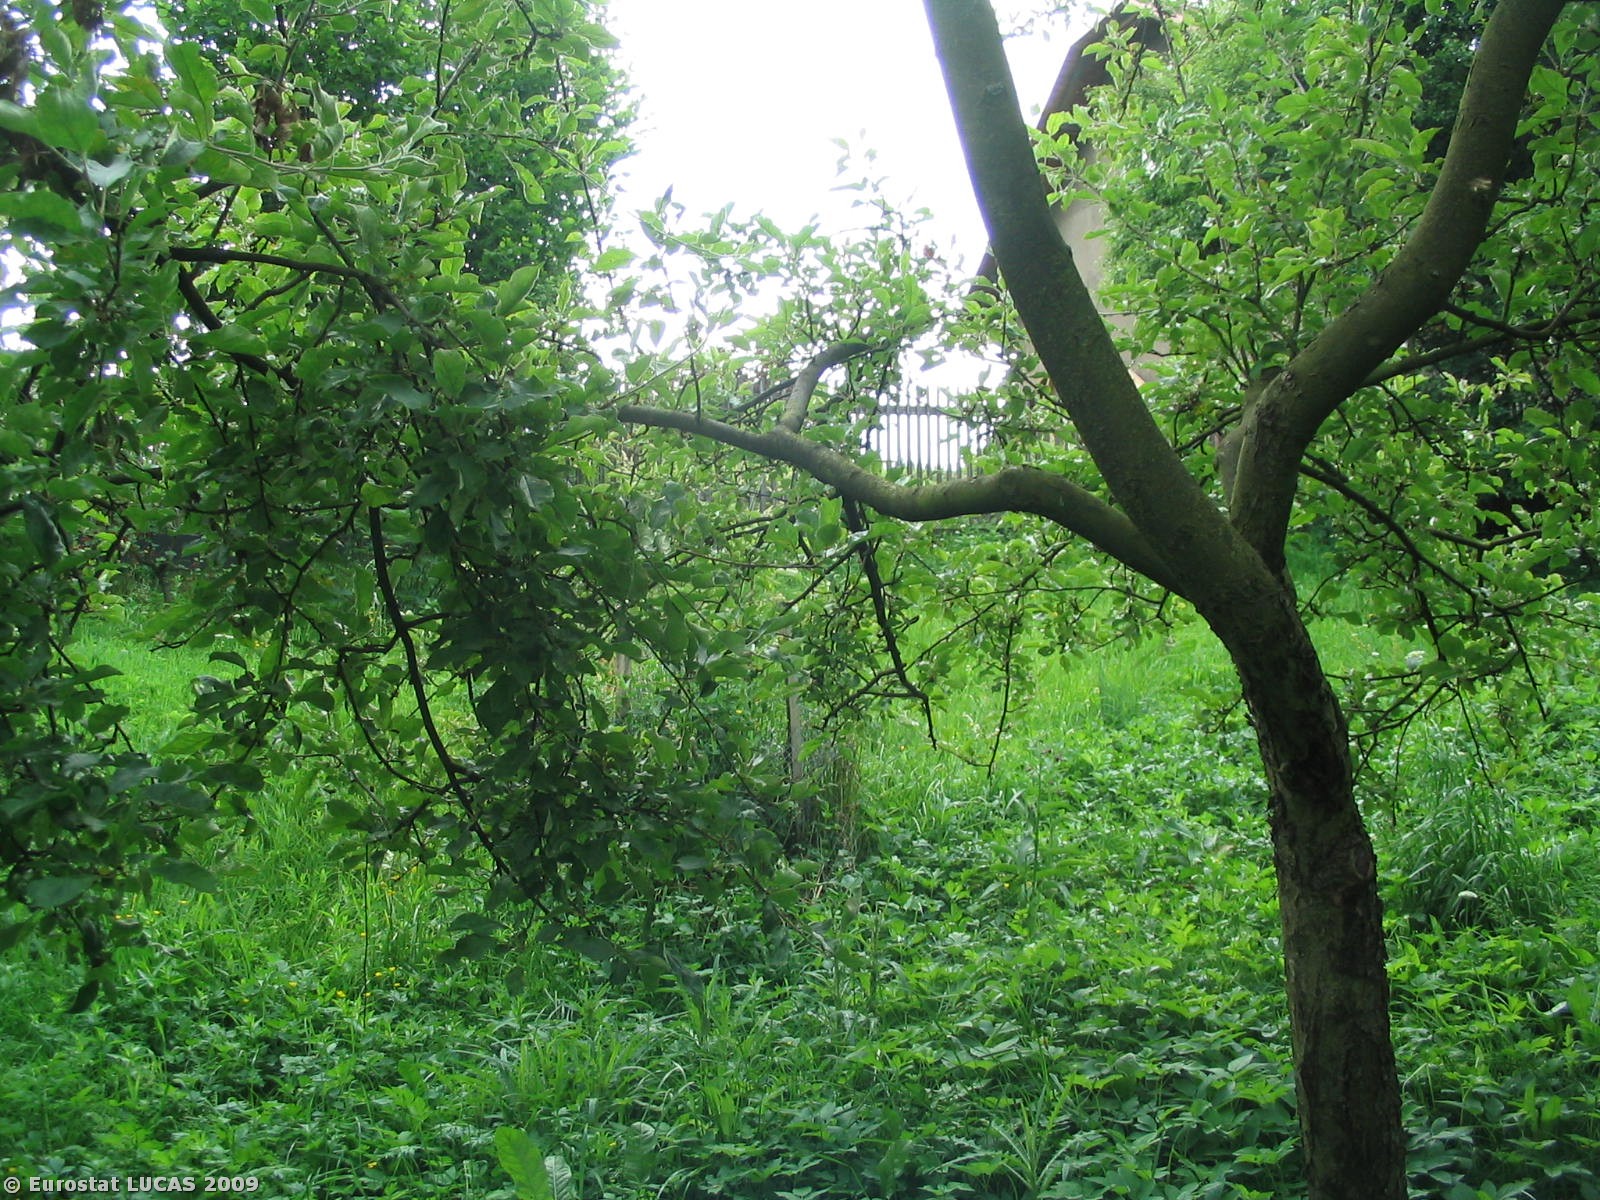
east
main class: Cropland
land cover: Apple fruit
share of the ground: 50 - 75 %
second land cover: Grassland with sparse tree/shrub cover
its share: > 75 %
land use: Kitchen garden
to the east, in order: Apple fruit; Grassland with sparse tree/shrub cover; Fences; Artificial constructions in urban areas; Fences; Broadleaved woodland; Electric lines; Grassland without tree/shrub cover; Fences; Artificial constructions in urban areas; Fences; Grass margins; Tracks; Electric lines; Grassland without tree/shrub cover; Paved roads, cycling and walking lanes; Grassland without tree/shrub cover
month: June
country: CZ
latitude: 49.5762
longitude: 18.7468
